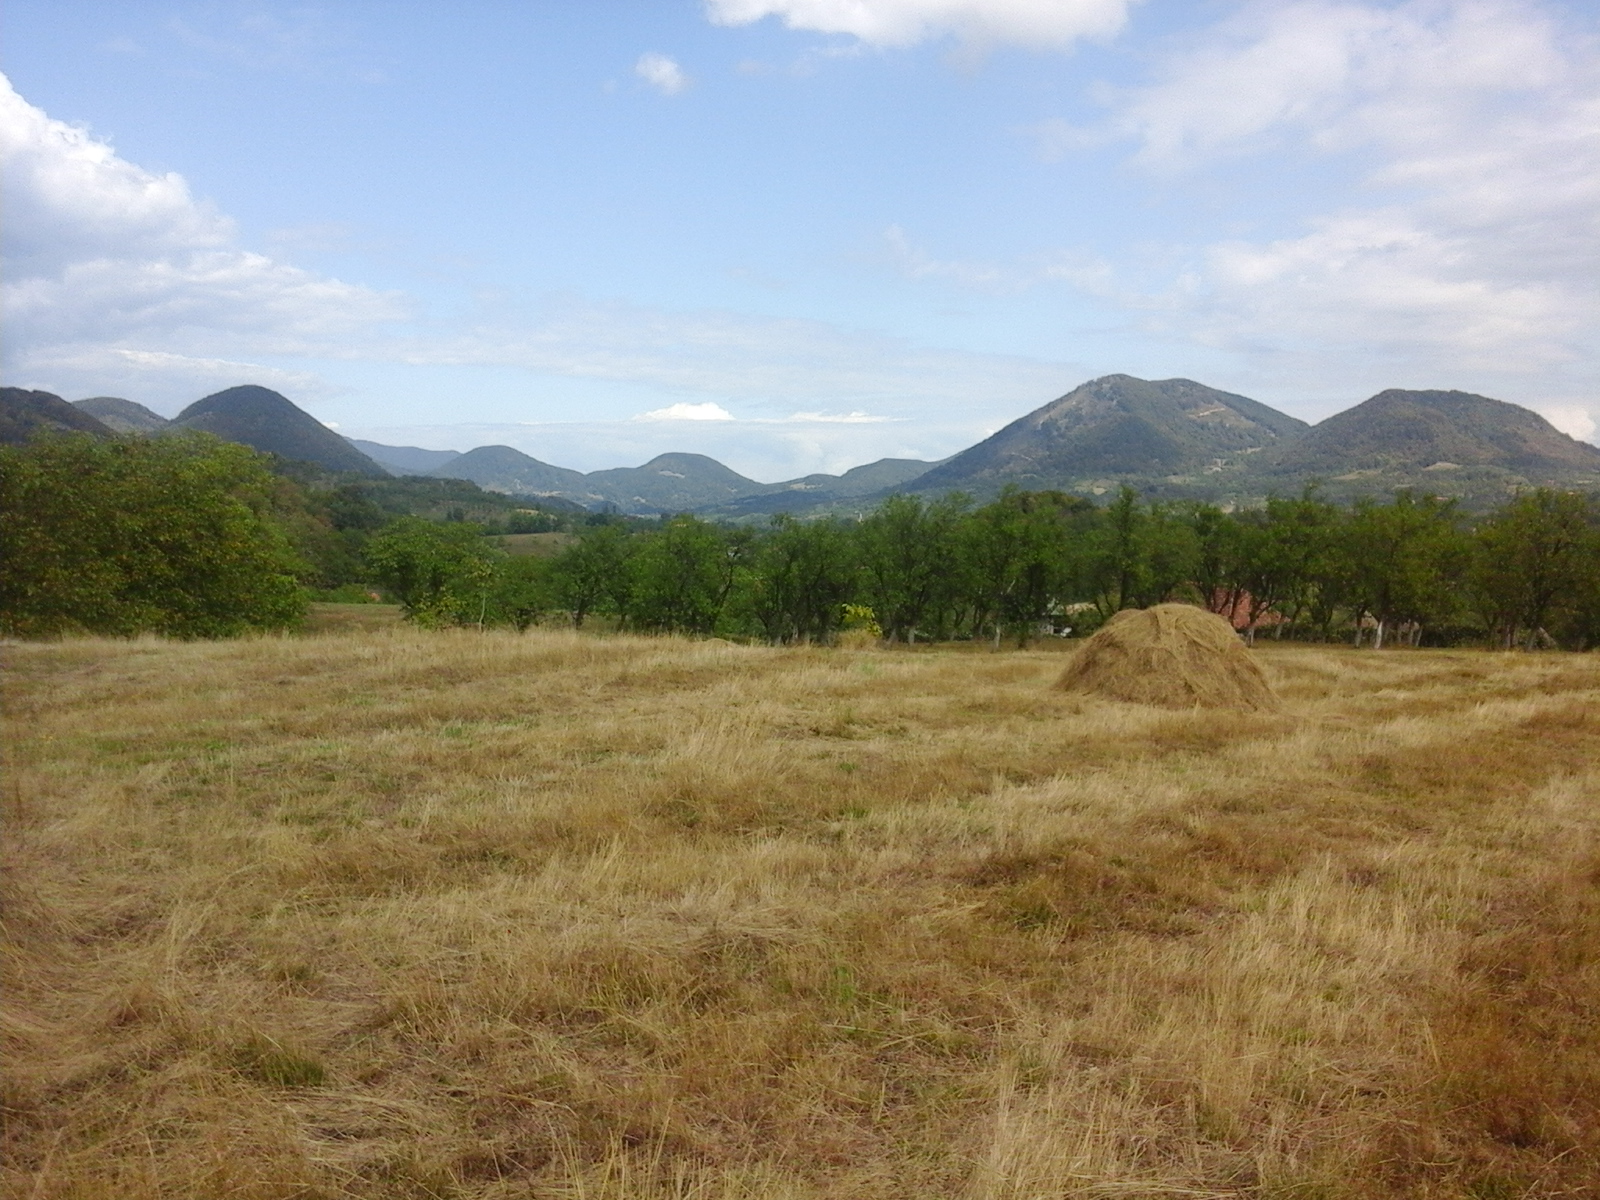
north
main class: Grassland
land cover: Grassland without tree/shrub cover
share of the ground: > 75 %
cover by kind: herbaceous plants 100 %
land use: Agriculture (excluding fallow land and kitchen gardens)
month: September
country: RO
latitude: 47.9791
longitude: 23.2958
